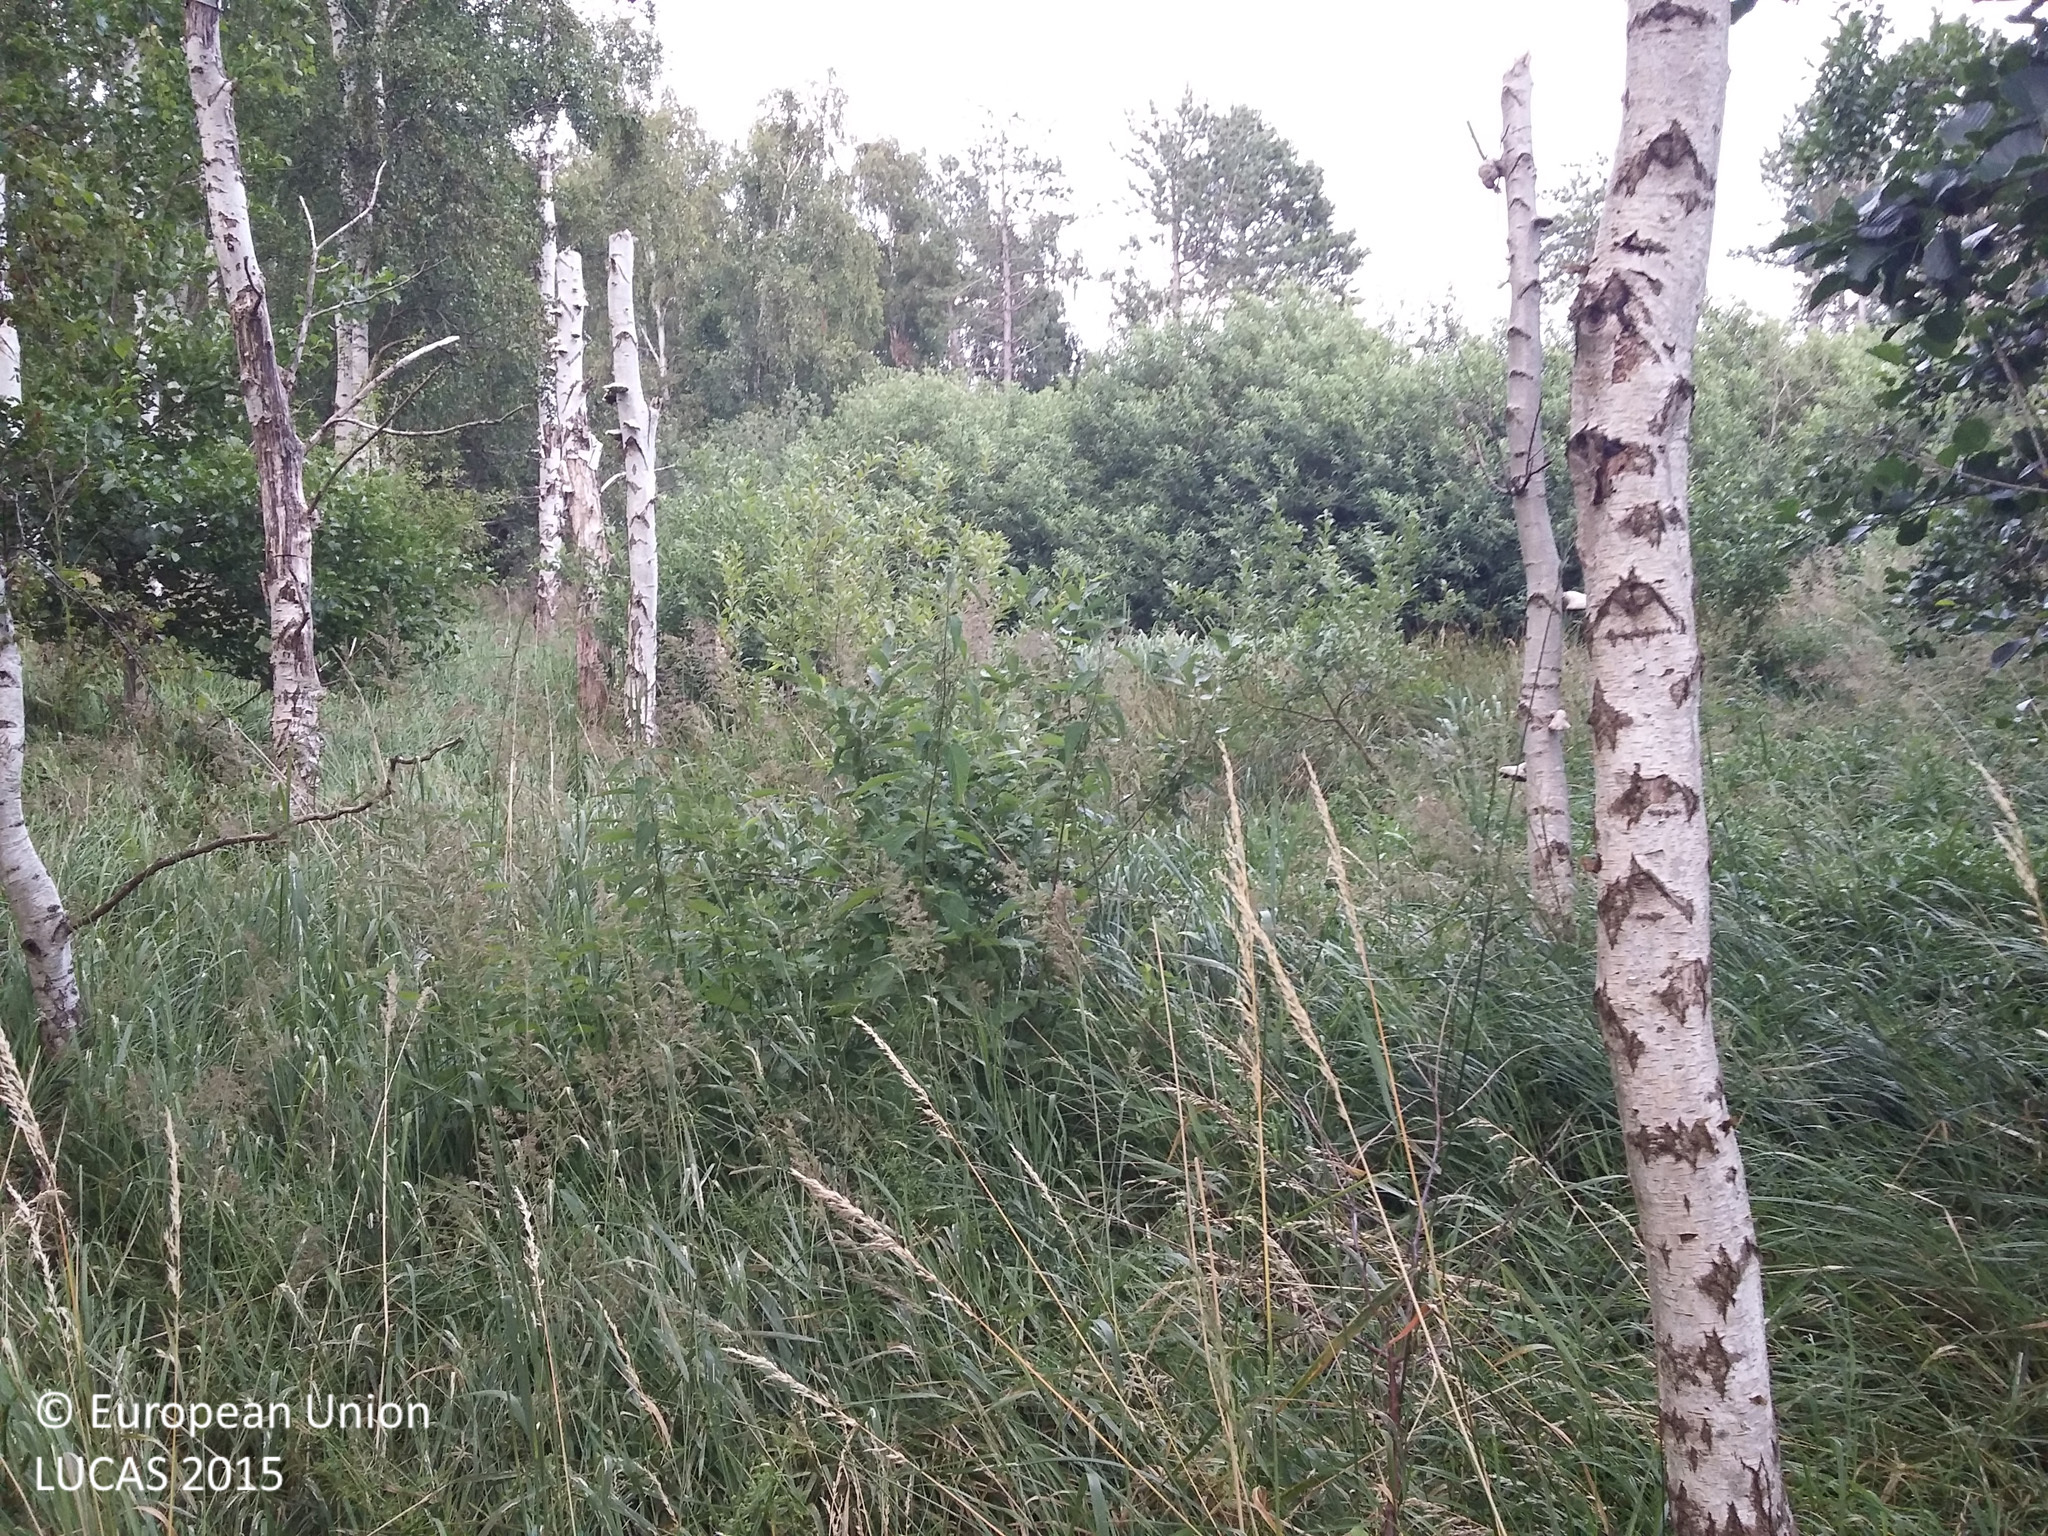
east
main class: Woodland
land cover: Broadleaved woodland
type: non-riverine alder, birch or aspen forest
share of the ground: > 75 %
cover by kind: broadleaved forest trees 70 %, herbaceous plants 30 %
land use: Community services
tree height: > 5 m
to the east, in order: Broadleaved woodland; Grassland without tree/shrub cover; Fences; Artificial constructions in urban areas; Fences; Grassland without tree/shrub cover; Pine dominated mixed woodland
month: July
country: DK
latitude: 55.9035
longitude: 11.9335
